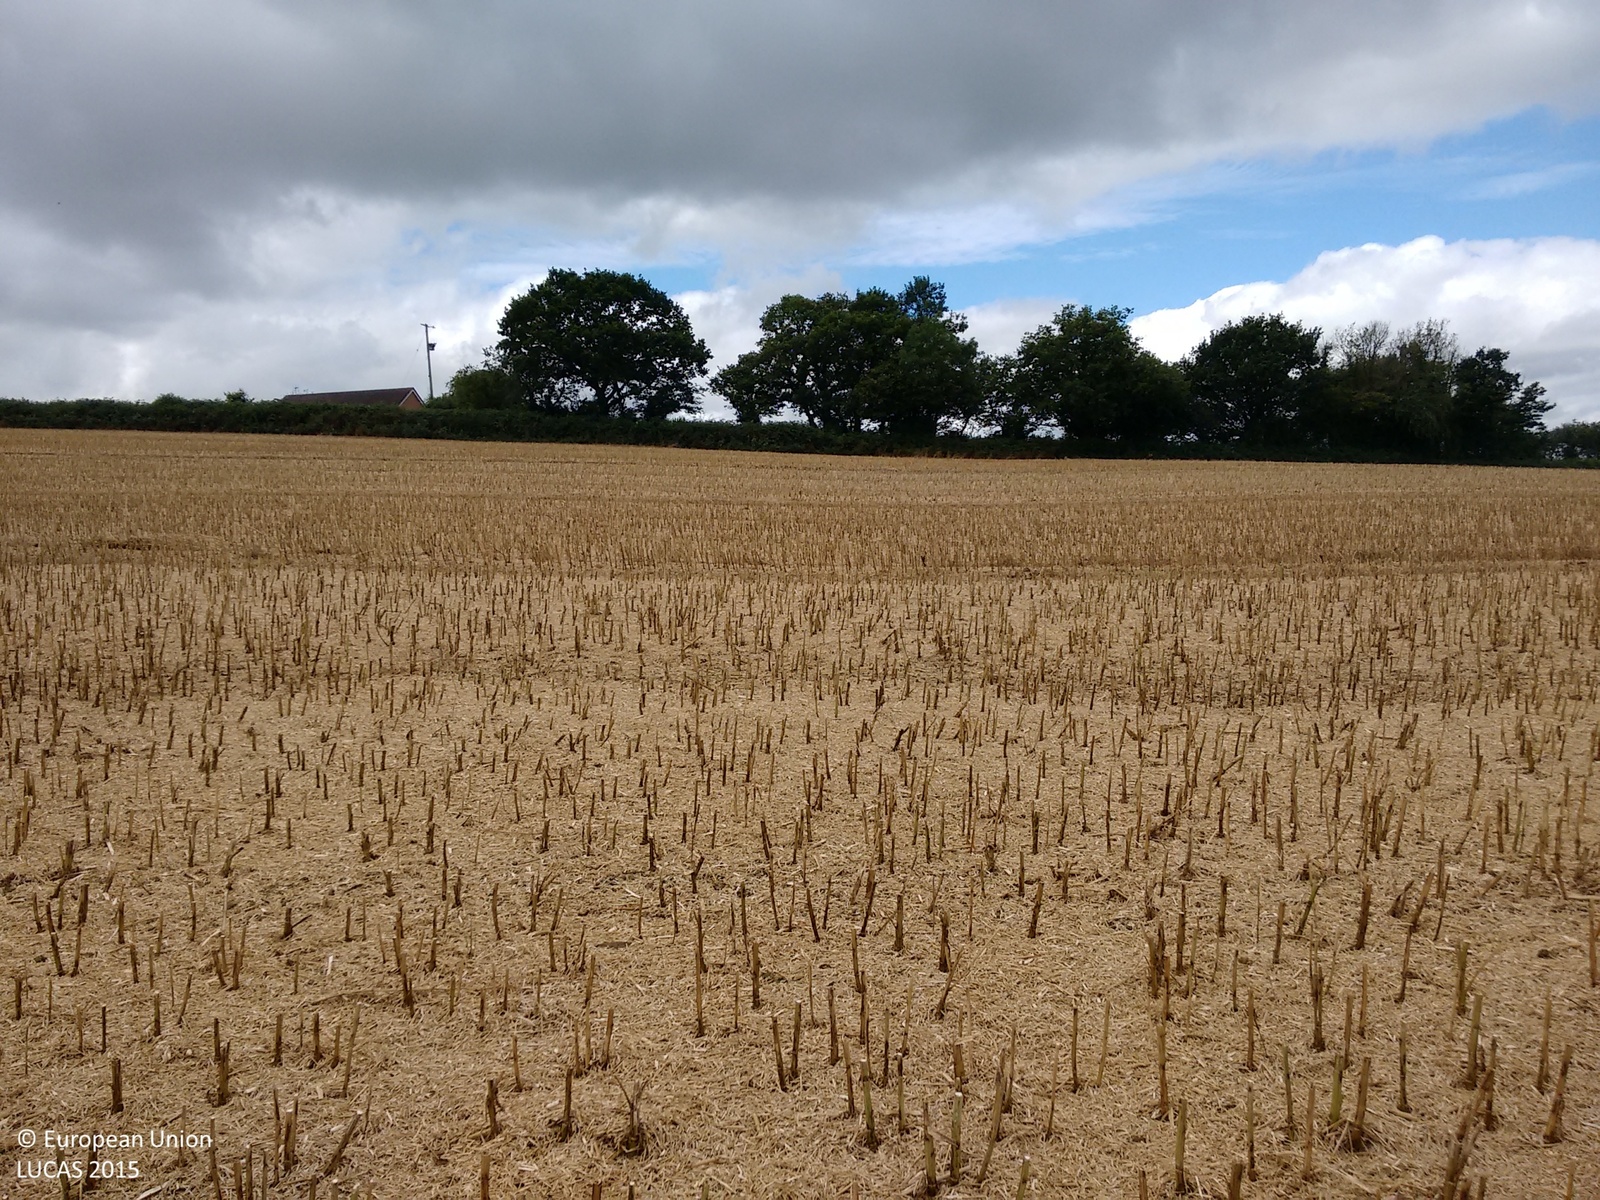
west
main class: Cropland
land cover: Rape and turnip rape
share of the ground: 10 - 25 %
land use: Agriculture (excluding fallow land and kitchen gardens)
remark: Harvested field
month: August
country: GB
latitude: 50.7625
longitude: -3.6546
